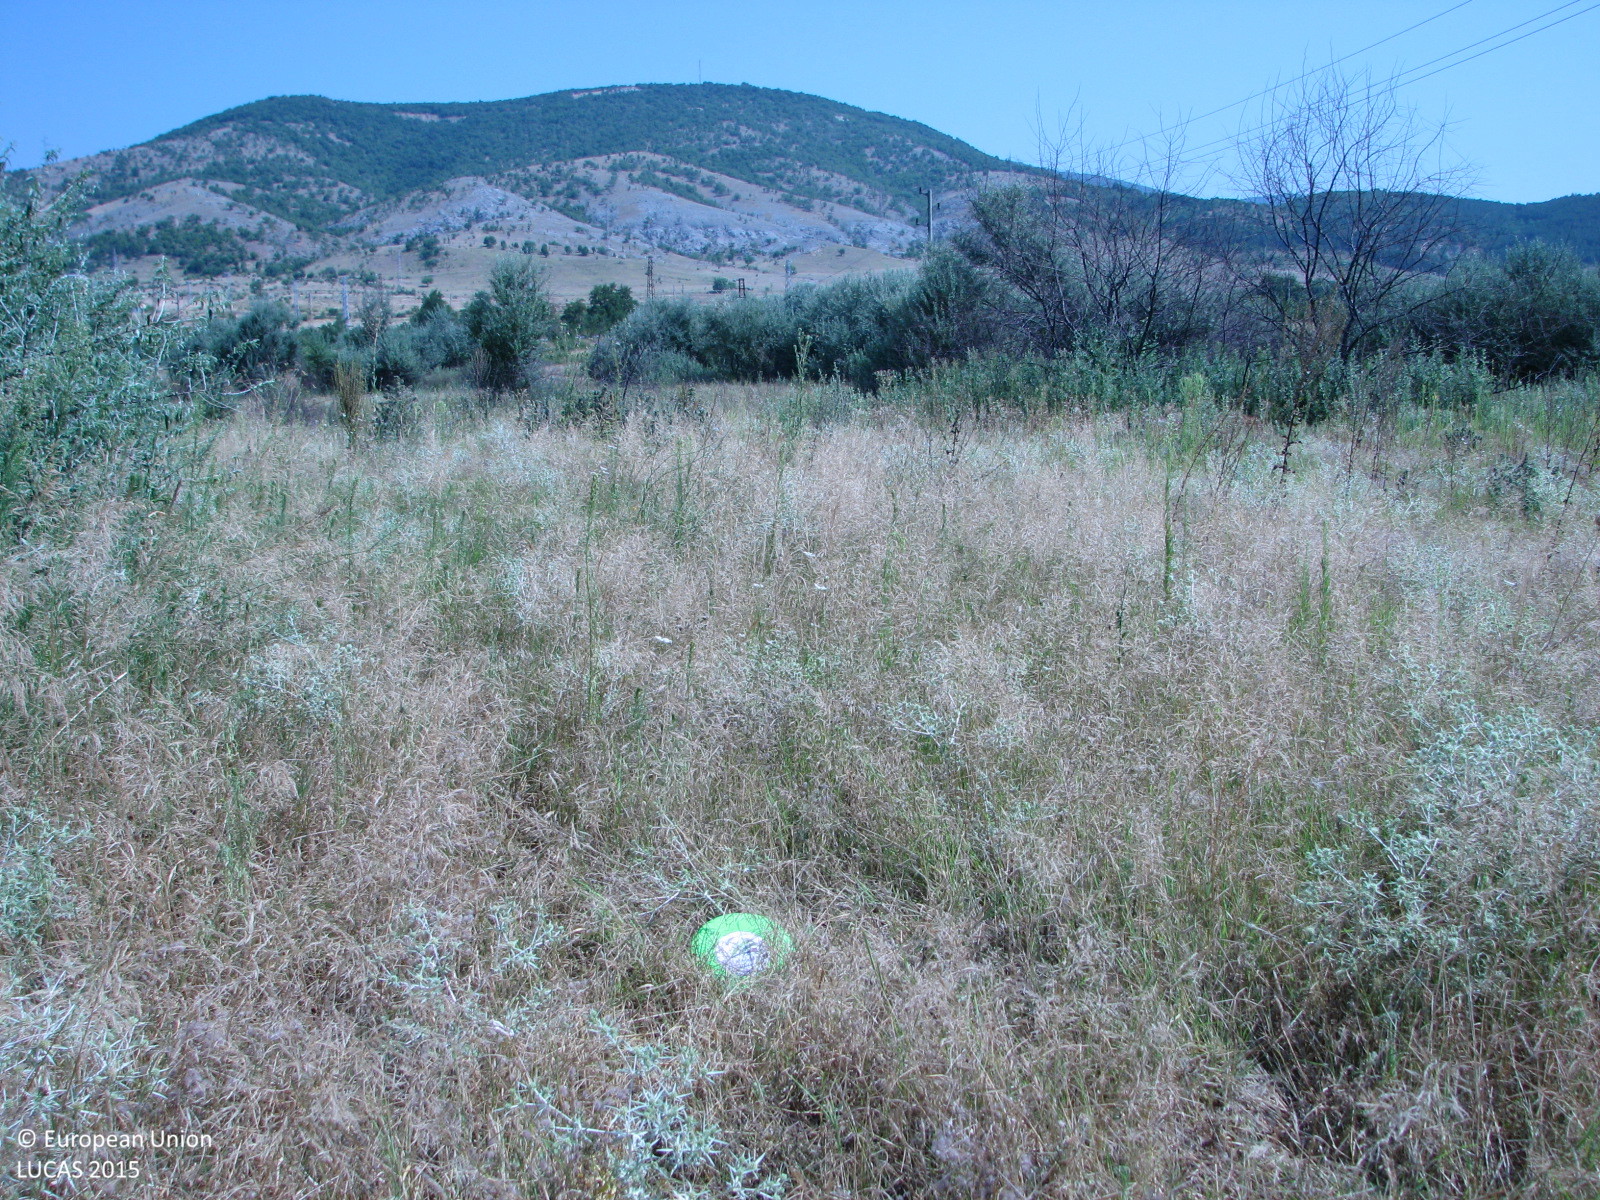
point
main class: Grassland
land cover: Grassland with sparse tree/shrub cover
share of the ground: > 75 %
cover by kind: herbaceous plants 90 %, broadleaved forest trees 5 %, shrubs 5 %
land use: Abandoned areas
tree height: < 5 m
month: July
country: BG
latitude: 42.6389
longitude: 26.1225
